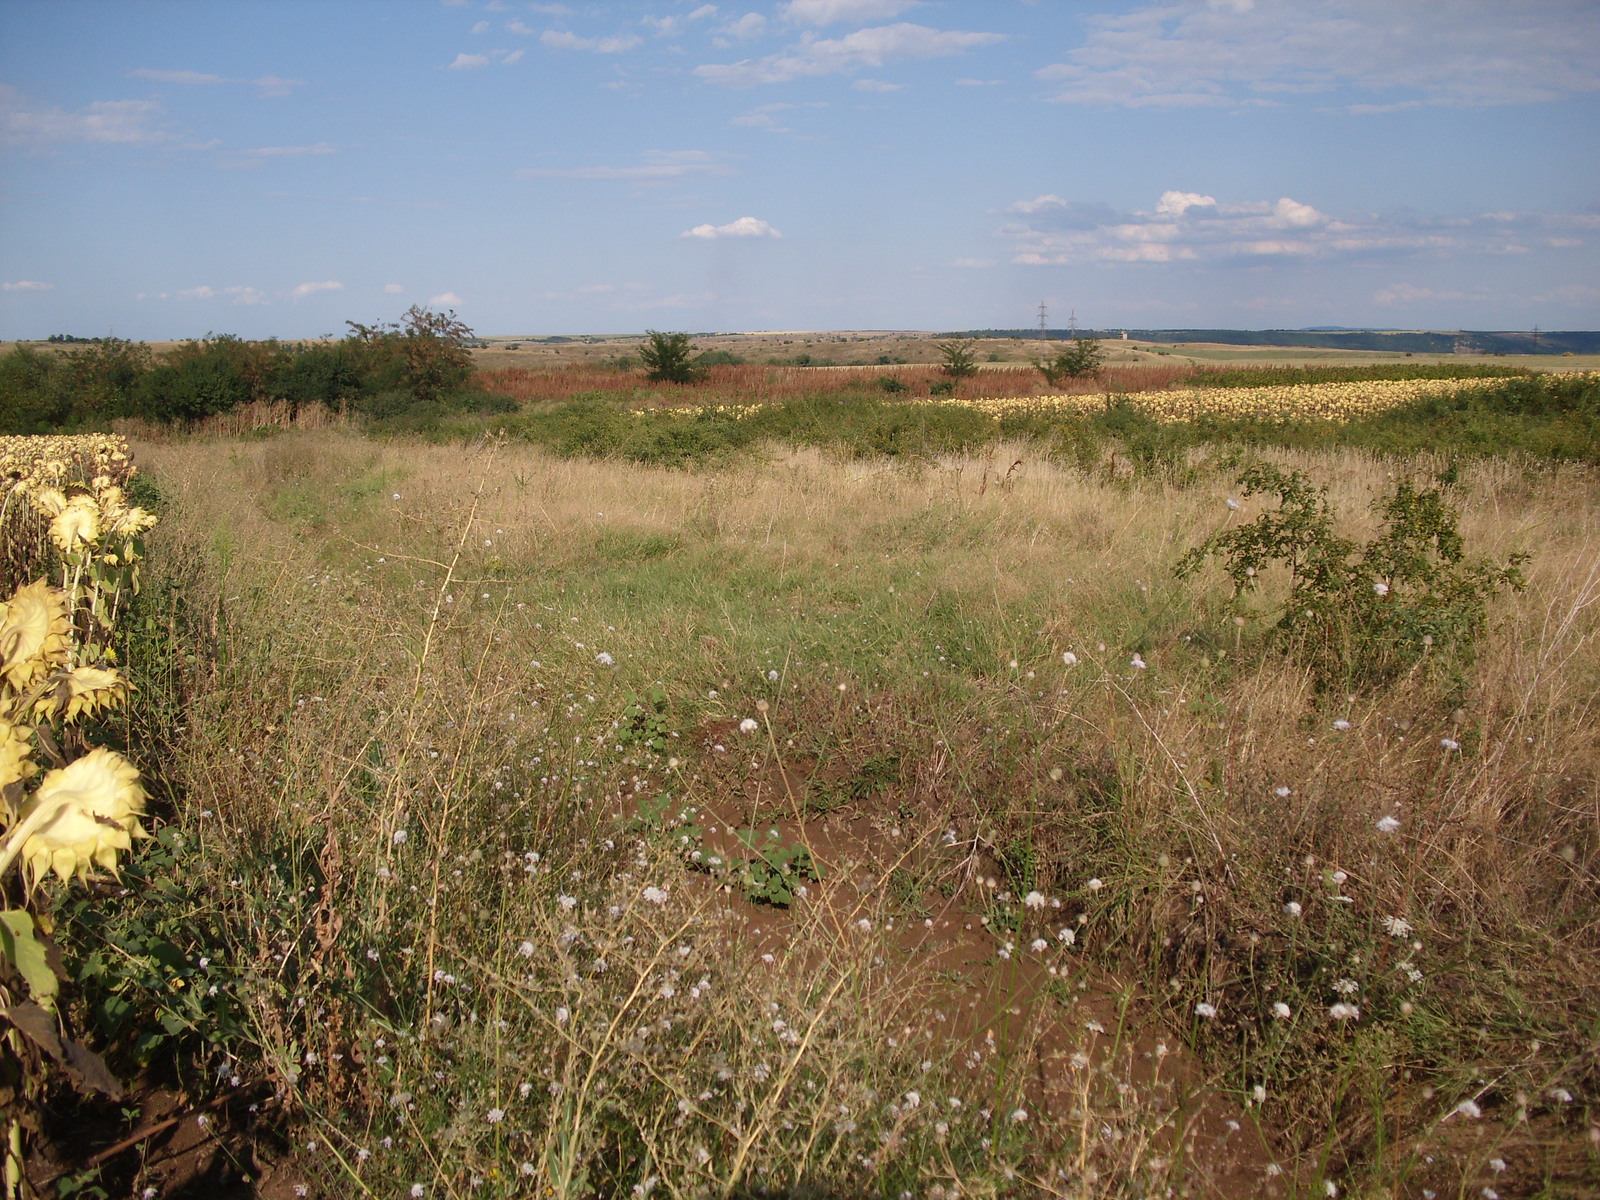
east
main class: Cropland
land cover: Sunflower
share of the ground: > 75 %
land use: Agriculture (excluding fallow land and kitchen gardens)
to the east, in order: Sunflower; Grassland with sparse tree/shrub cover; Tracks; Grass margins; Shrubland without tree cover
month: August
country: BG
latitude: 43.4052
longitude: 23.3904
